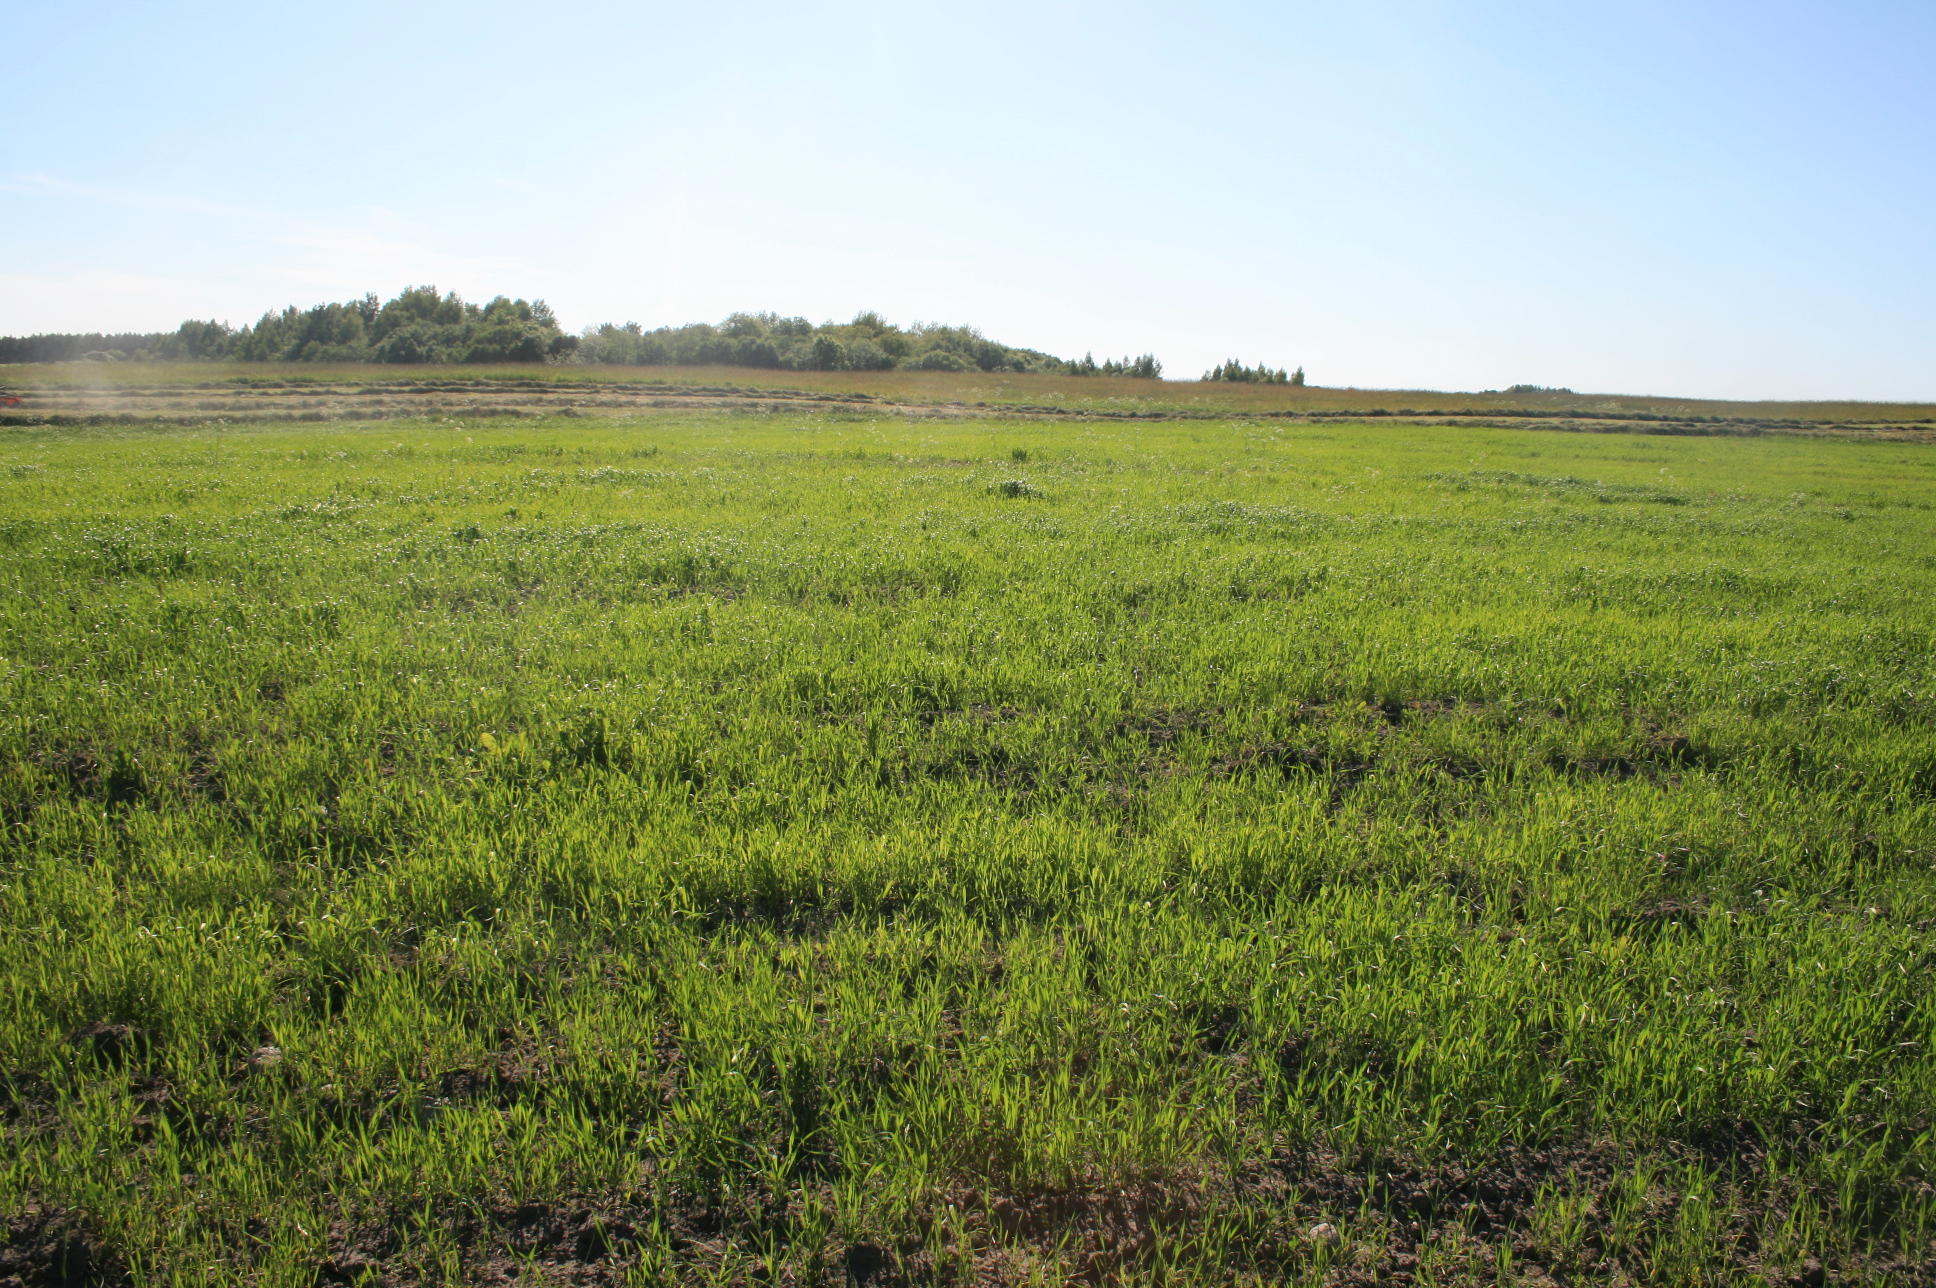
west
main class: Grassland
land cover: Grassland without tree/shrub cover
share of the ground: > 75 %
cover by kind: herbaceous plants 100 %
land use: Agriculture (excluding fallow land and kitchen gardens)
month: June
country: LT
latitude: 55.5471
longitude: 22.2129
